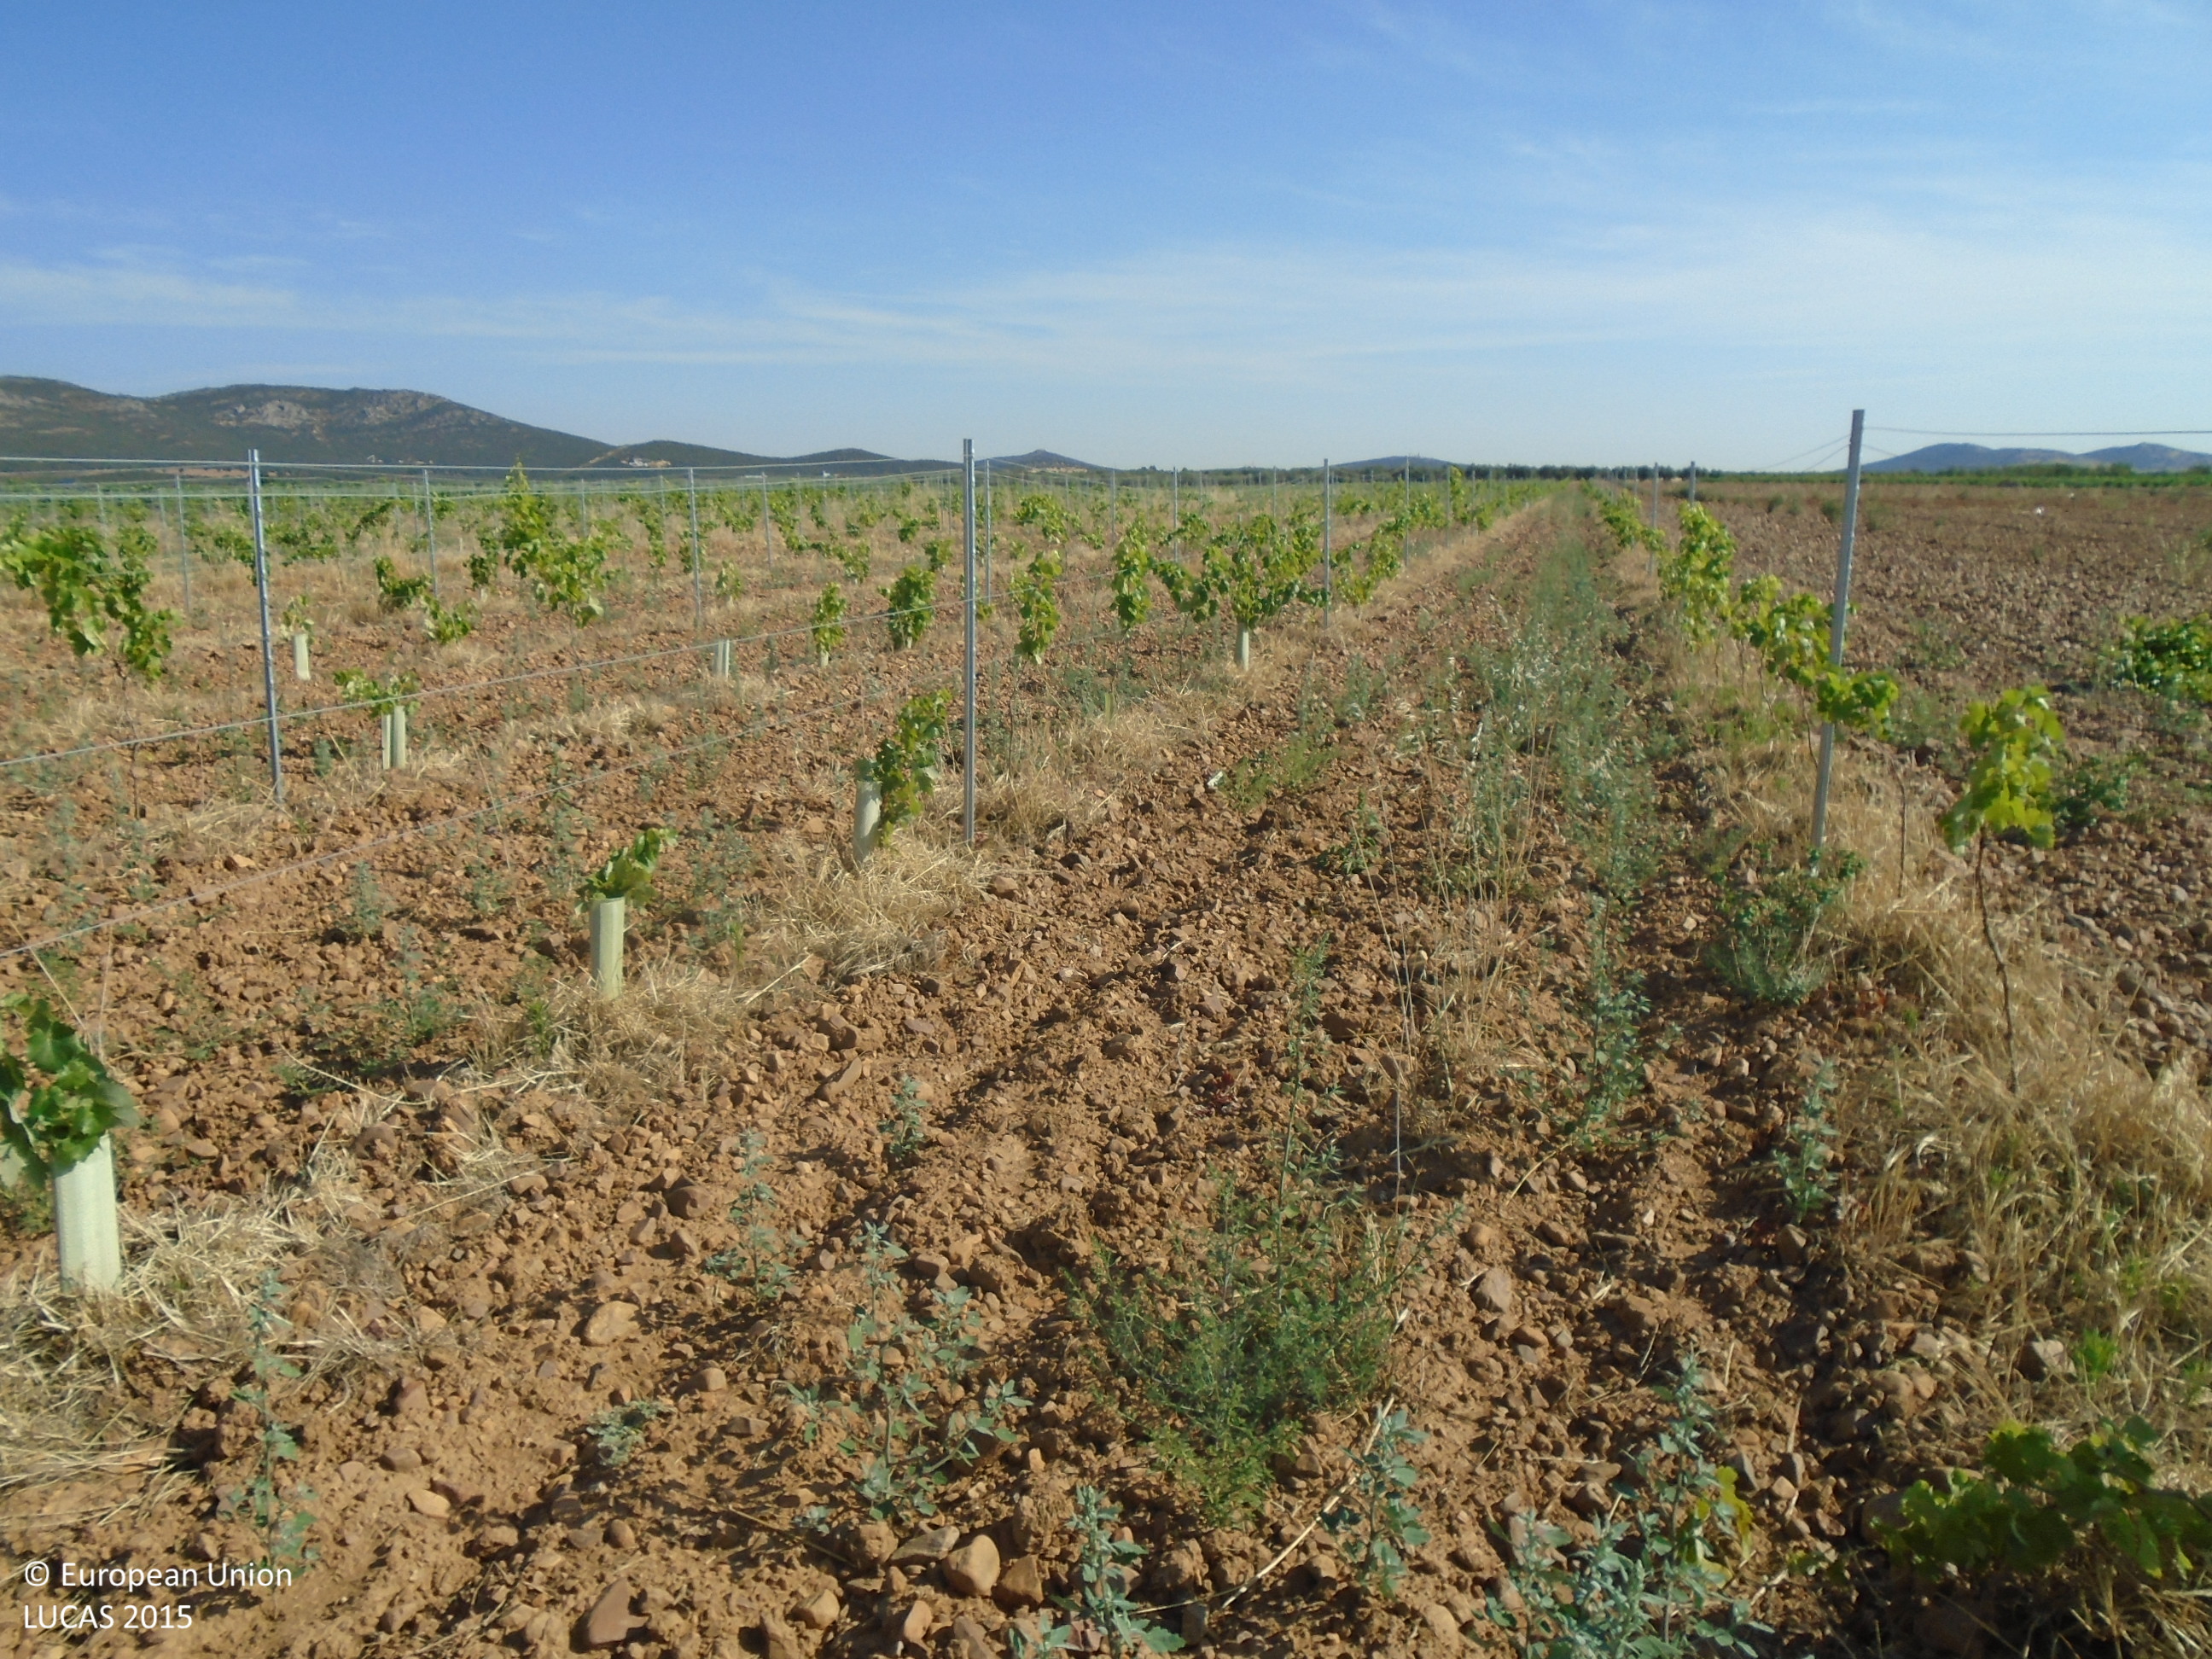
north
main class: Cropland
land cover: Vineyards
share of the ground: < 10 %
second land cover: Other bare soil
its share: > 75 %
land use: Agriculture (excluding fallow land and kitchen gardens)
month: June
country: ES
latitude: 39.2745
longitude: -3.5006
